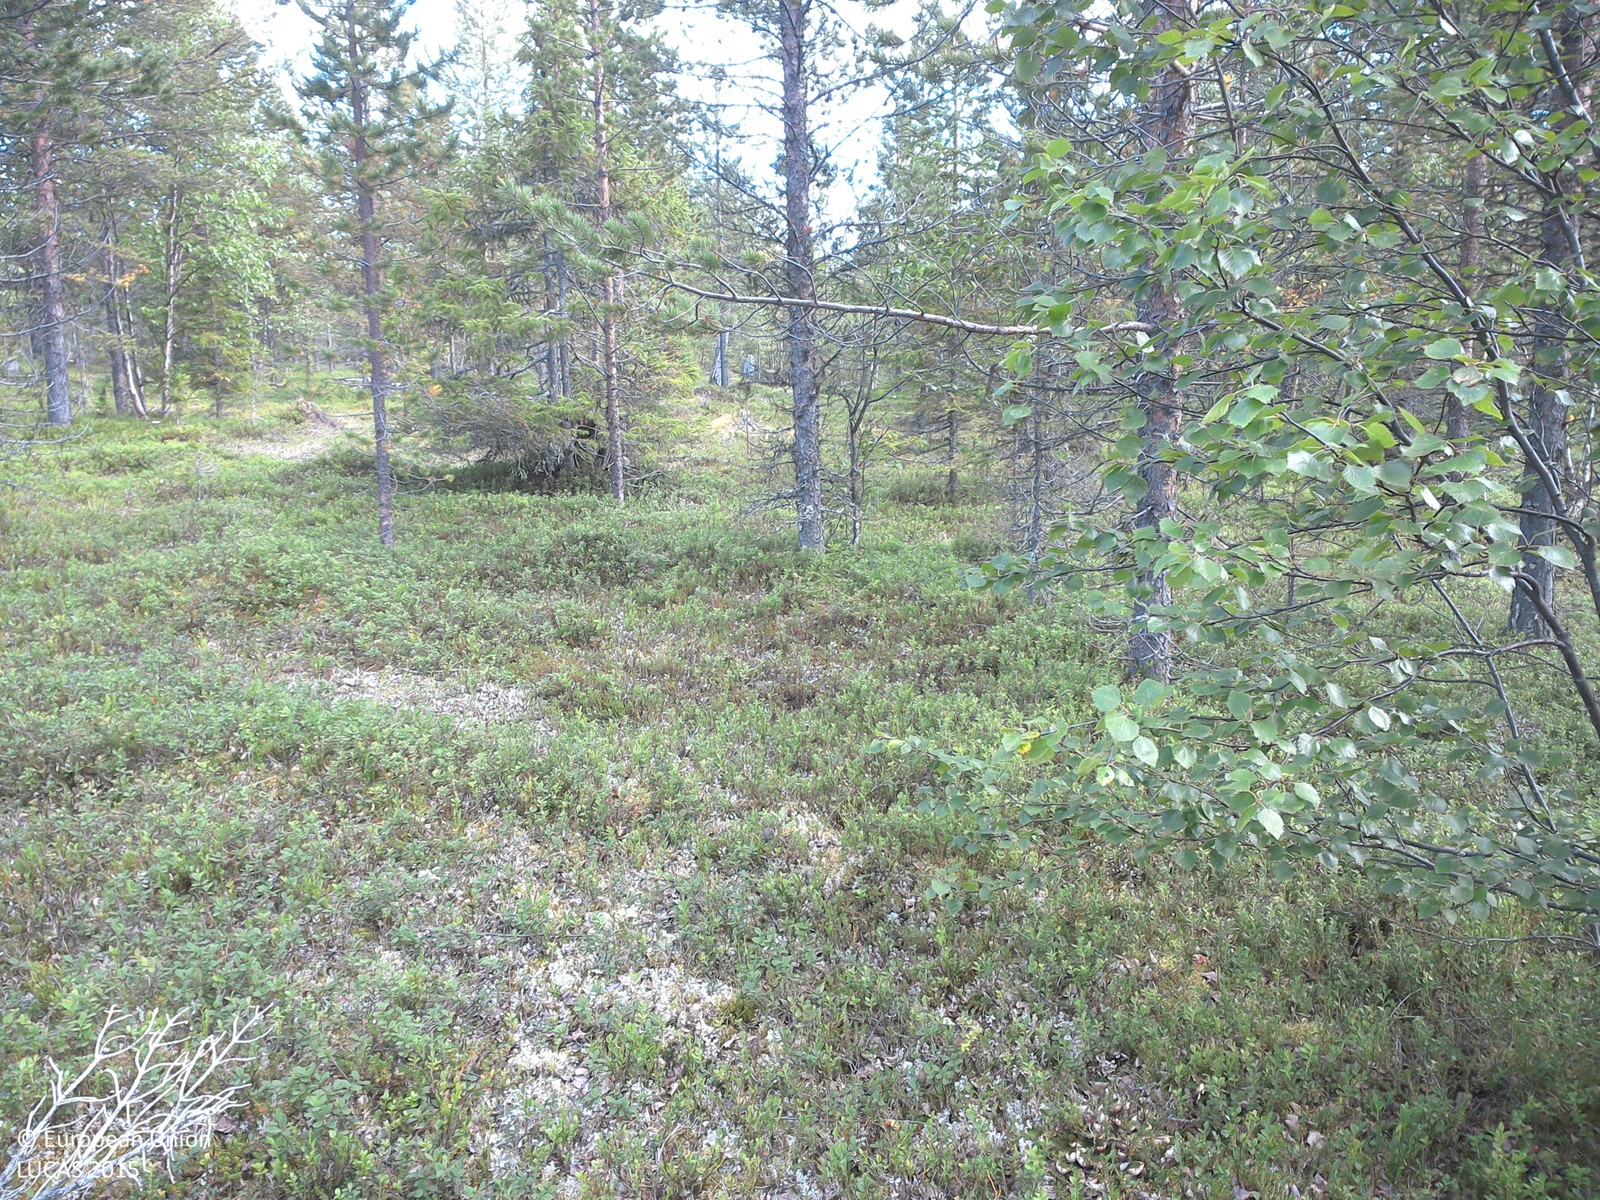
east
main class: Woodland
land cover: Pine dominated mixed woodland
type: boreal forest
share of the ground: 25 - 50 %
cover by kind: shrubs 50 %, coniferous forest trees 20 %, broadleaved forest trees 15 %, lichens and mosses 15 %
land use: Forestry
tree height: < 5 m
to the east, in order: Pine dominated mixed woodland
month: August
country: SE
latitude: 67.9048
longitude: 20.5406
